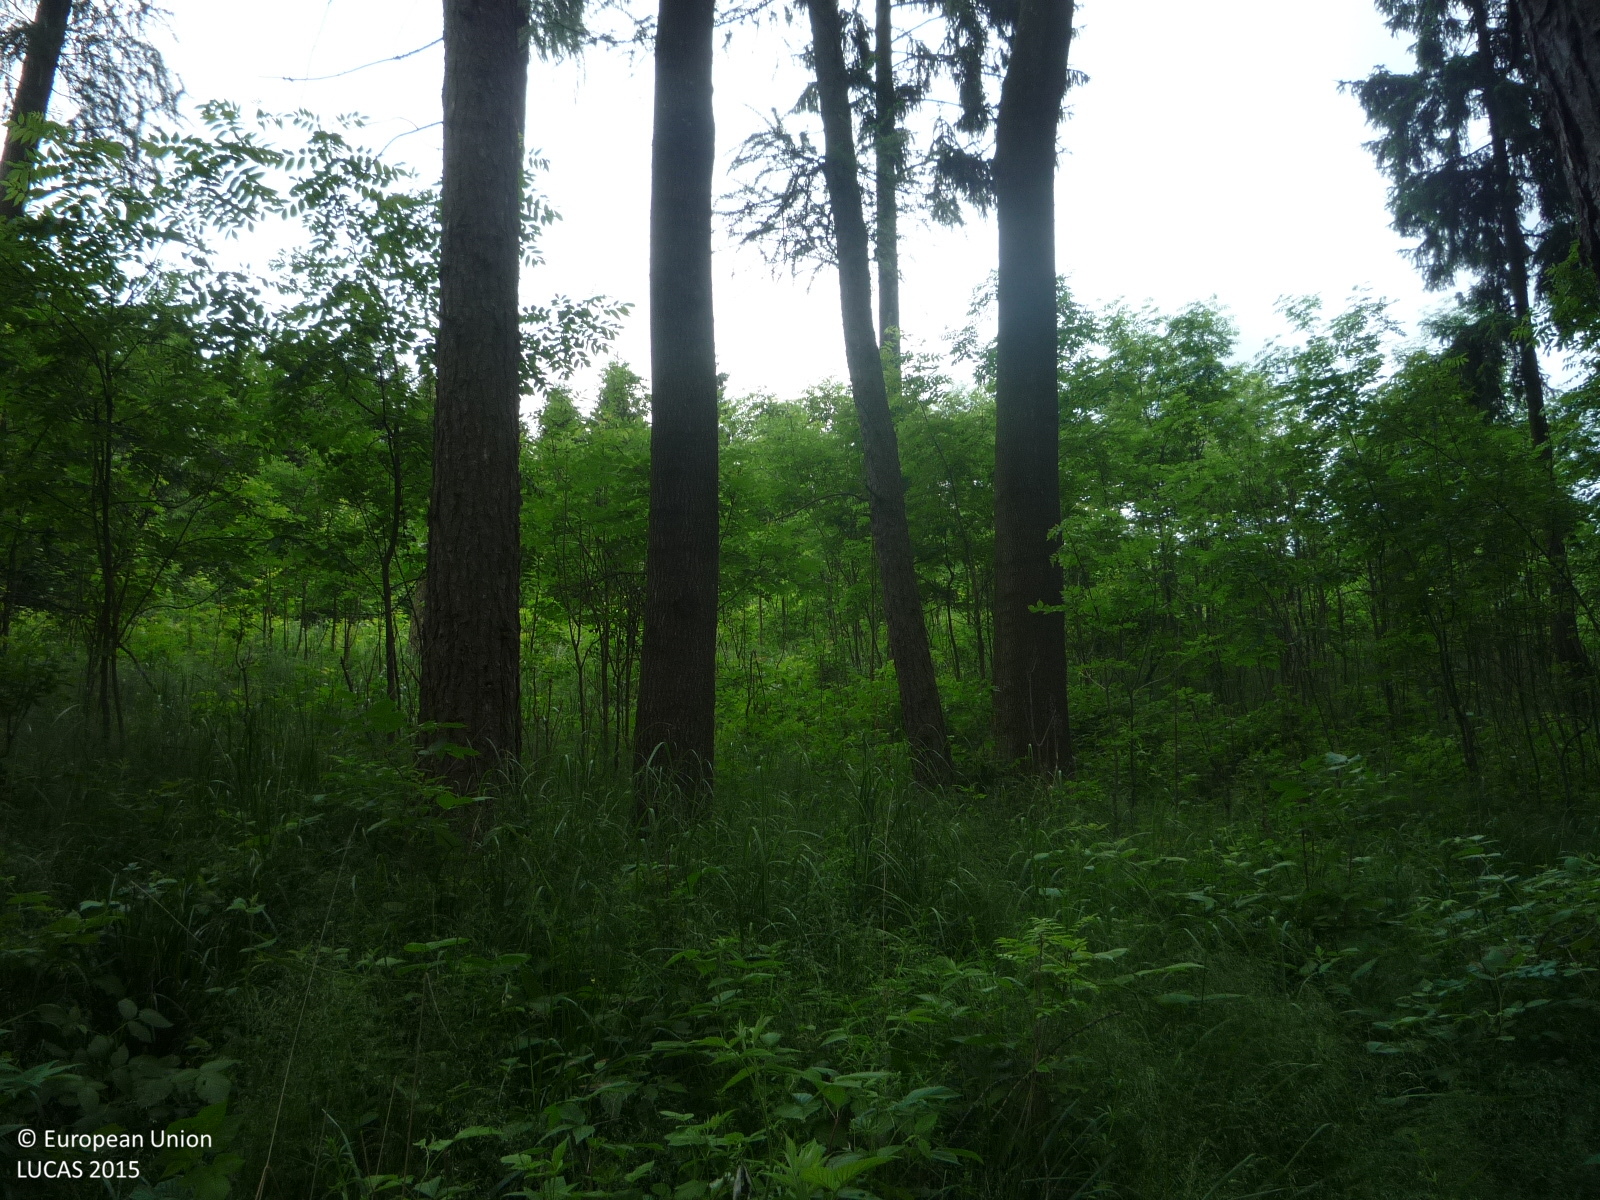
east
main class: Woodland
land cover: Other mixed woodland
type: hemiboreal forest and nemoral coniferous forest and mixed broadleaved-coniferous forest
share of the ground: > 75 %
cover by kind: coniferous forest trees 45 %, broadleaved forest trees 45 %, herbaceous plants 10 %
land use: Forestry
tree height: > 5 m
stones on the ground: 10 - 25 %
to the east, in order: Other mixed woodland; Broadleaved woodland; Spontaneously vegetated surfaces; Broadleaved woodland; Spruce dominated coniferous woodland; Broadleaved woodland; Other mixed woodland; Broadleaved woodland; Spruce dominated coniferous woodland; Other mixed woodland
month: June
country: CZ
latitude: 50.6291
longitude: 14.2000
